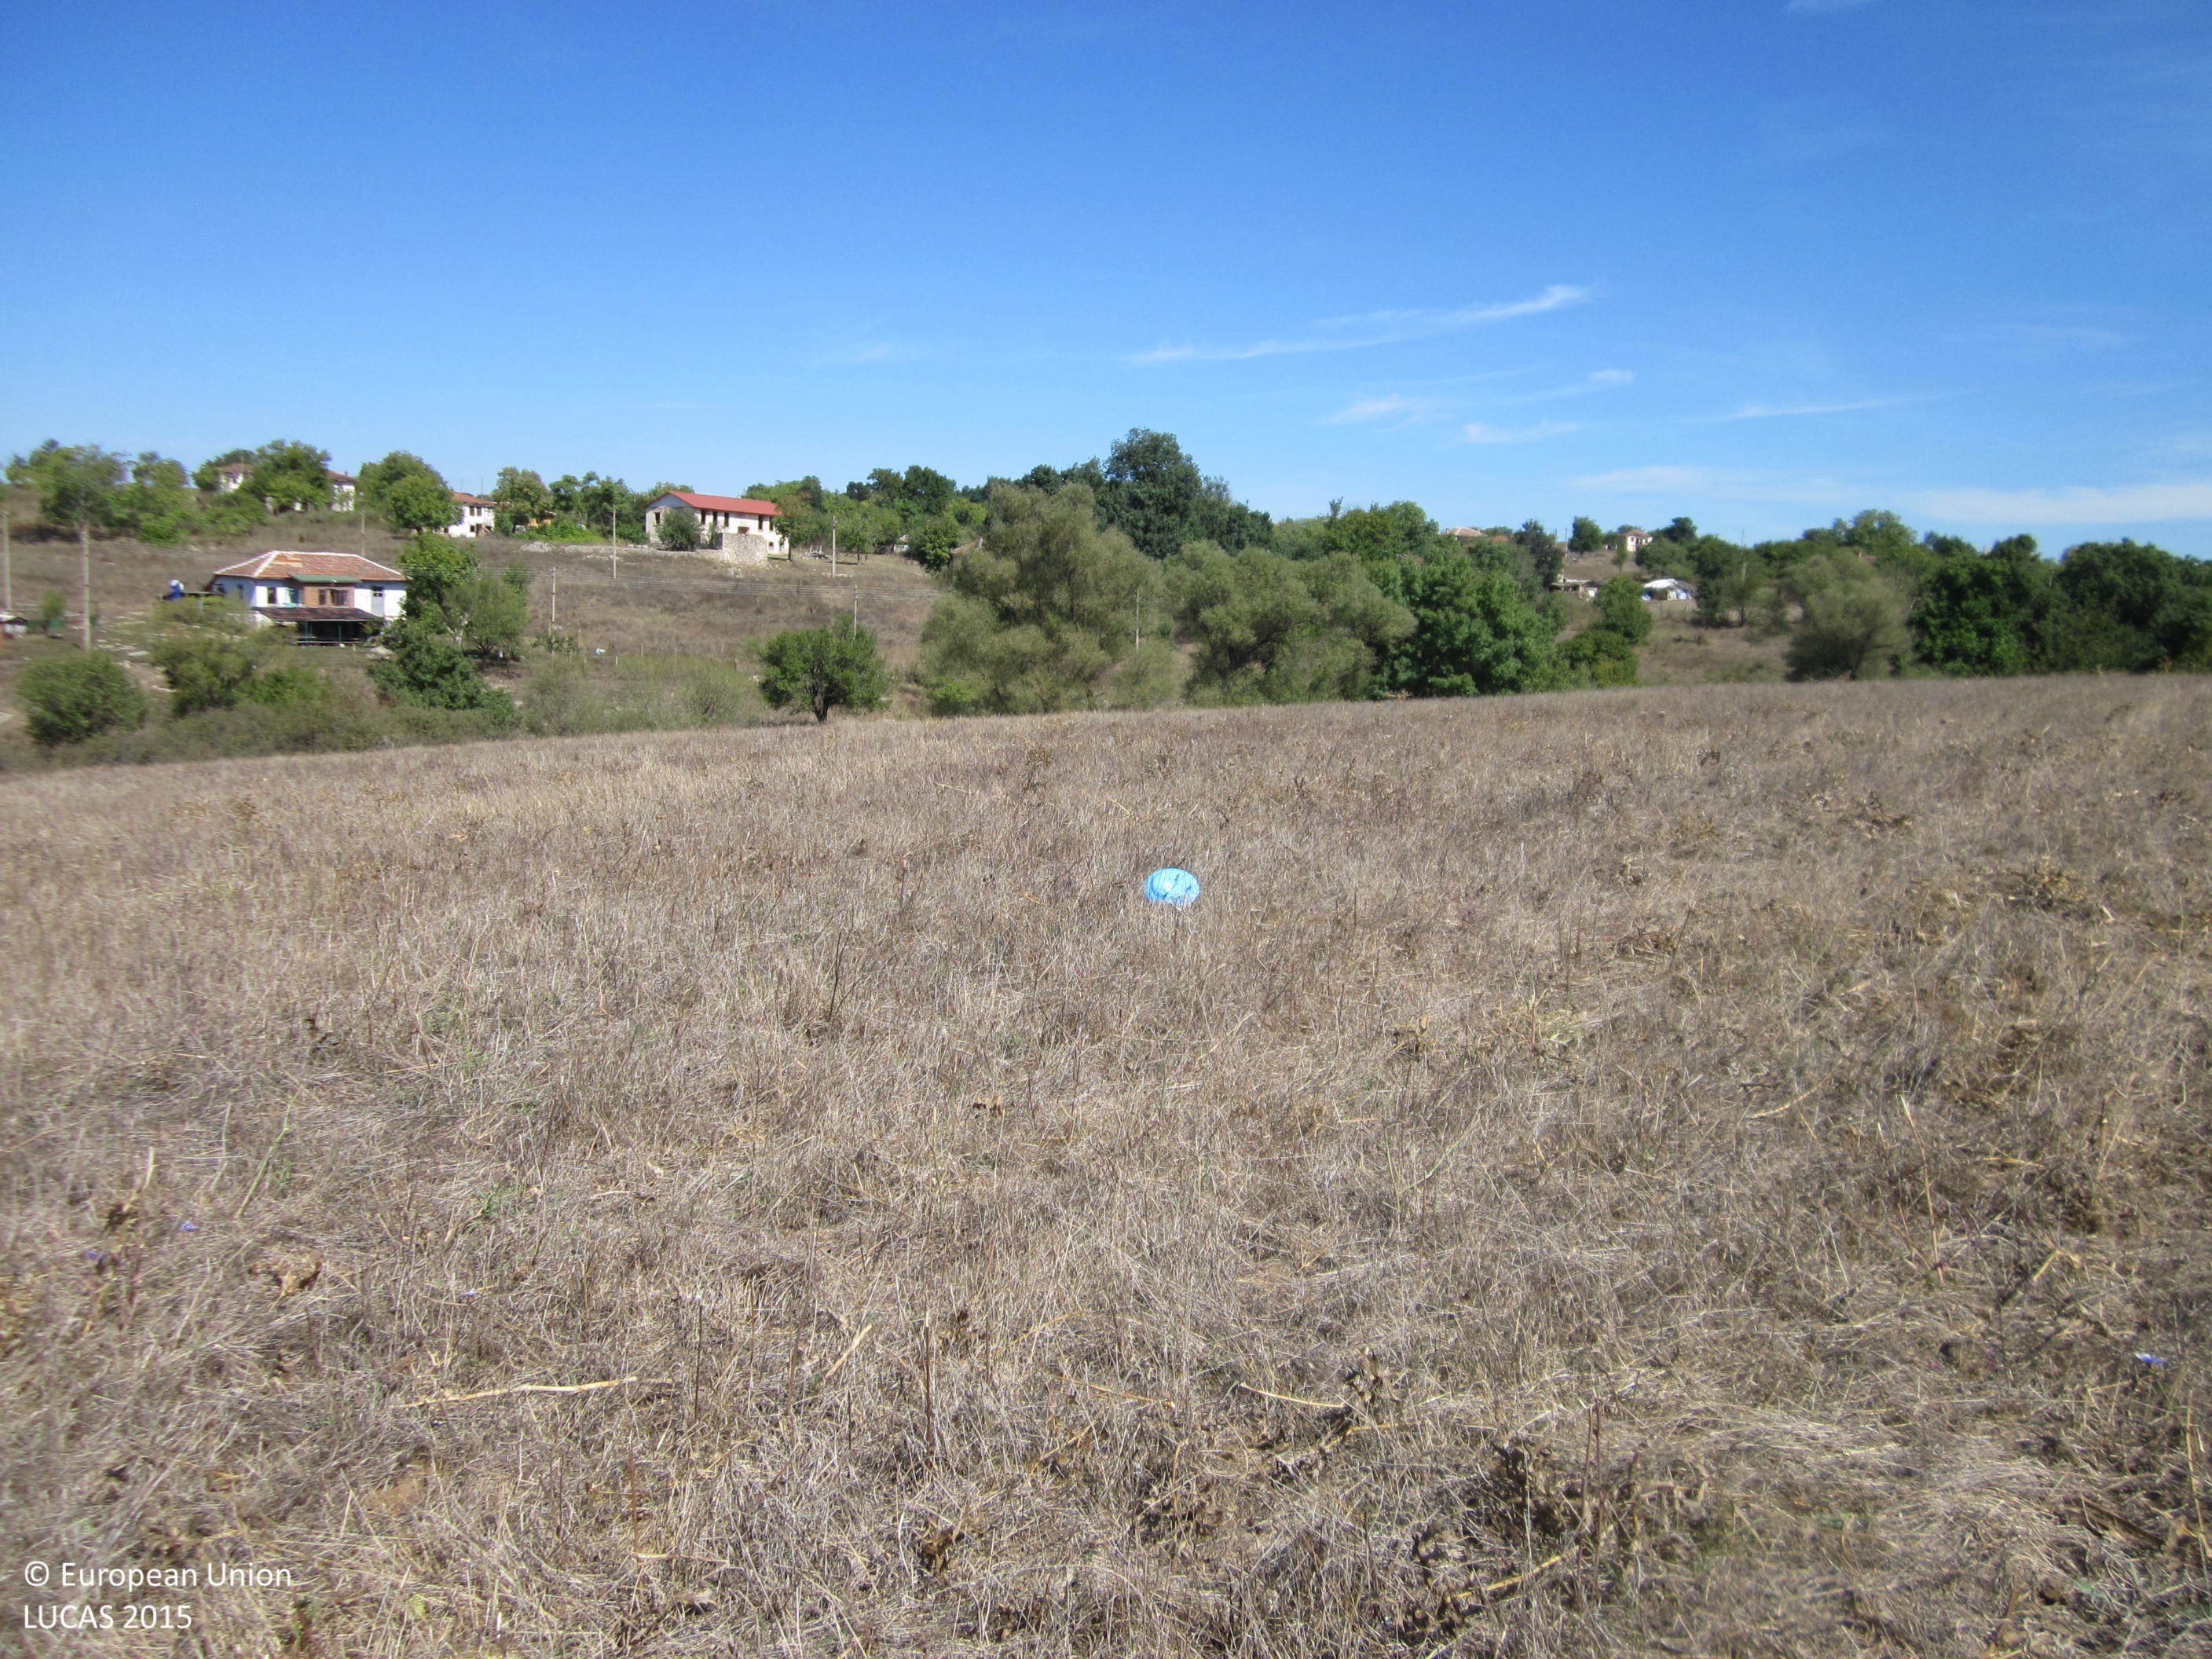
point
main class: Grassland
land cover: Grassland without tree/shrub cover
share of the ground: > 75 %
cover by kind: herbaceous plants 100 %
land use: Agriculture (excluding fallow land and kitchen gardens)
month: September
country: BG
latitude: 42.2430
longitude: 26.9576
